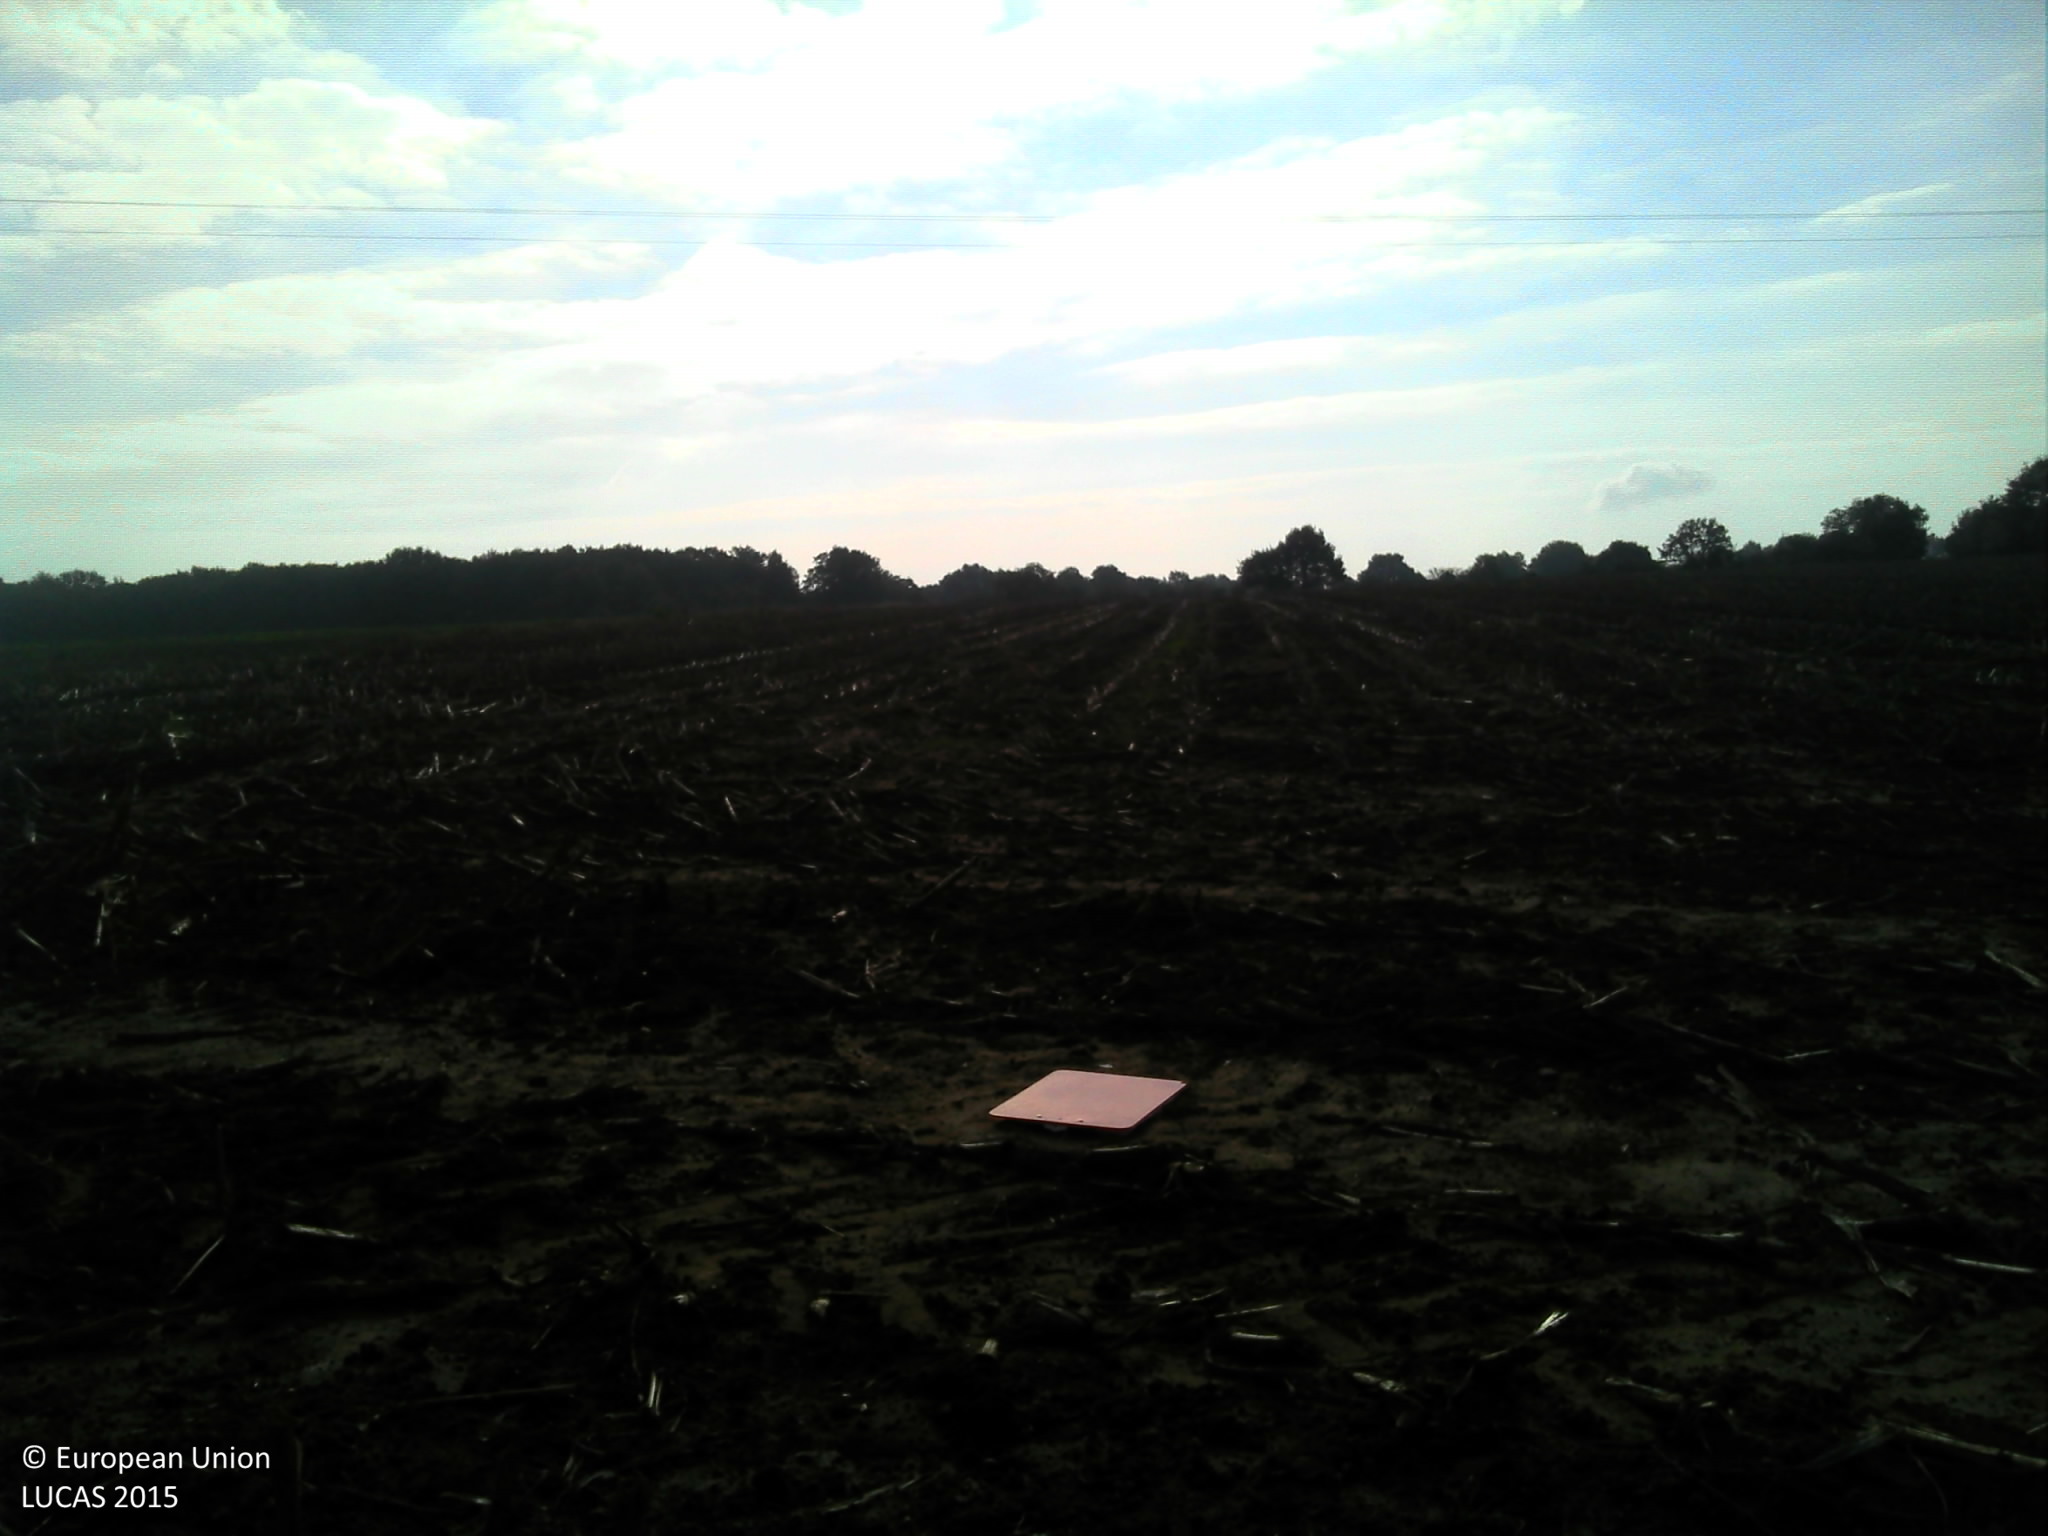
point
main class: Cropland
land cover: Maize
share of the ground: 25 - 50 %
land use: Agriculture (excluding fallow land and kitchen gardens)
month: October
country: FR
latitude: 47.1328
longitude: -0.9372
